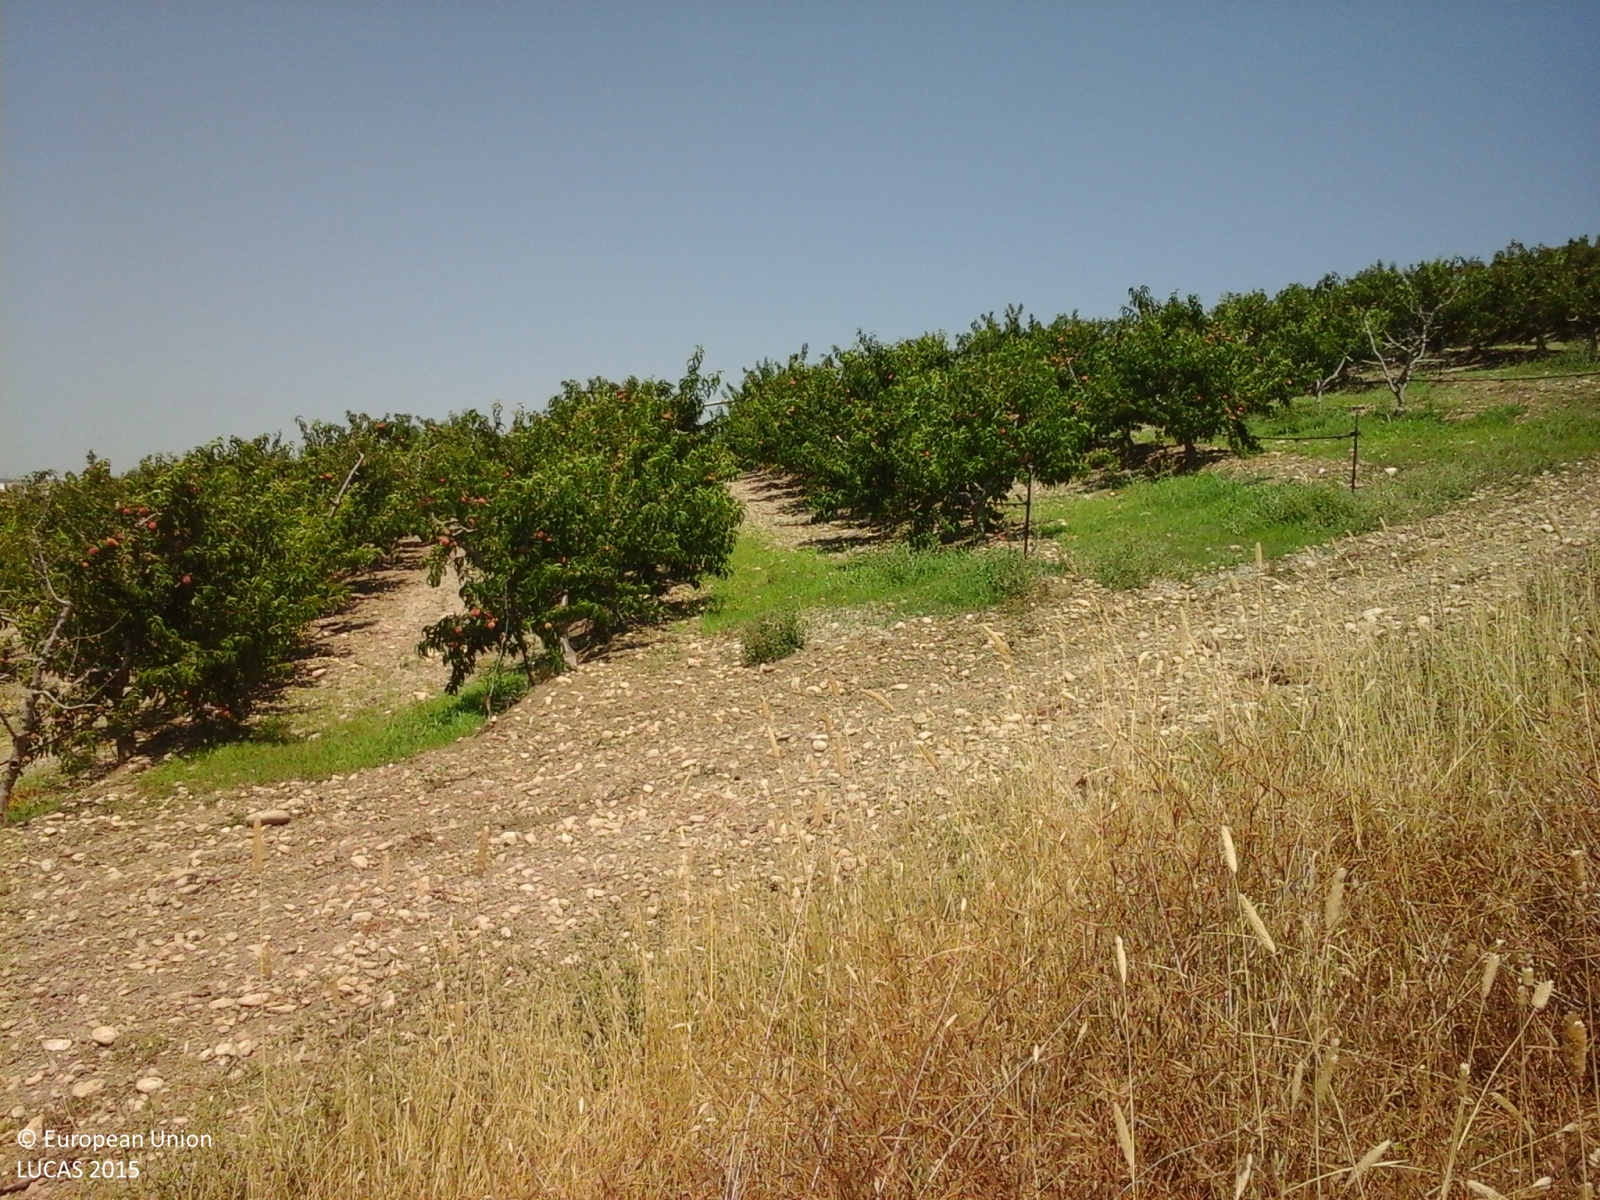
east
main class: Grassland
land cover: Spontaneously vegetated surfaces
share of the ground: > 75 %
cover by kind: herbaceous plants 100 %
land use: Fallow land
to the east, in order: Spontaneously vegetated surfaces; Single bushes/trees; Spontaneously vegetated surfaces; Electric lines; Spontaneously vegetated surfaces; Other fruit trees and berries; Olive groves
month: July
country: IT
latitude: 37.4750
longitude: 13.2205
